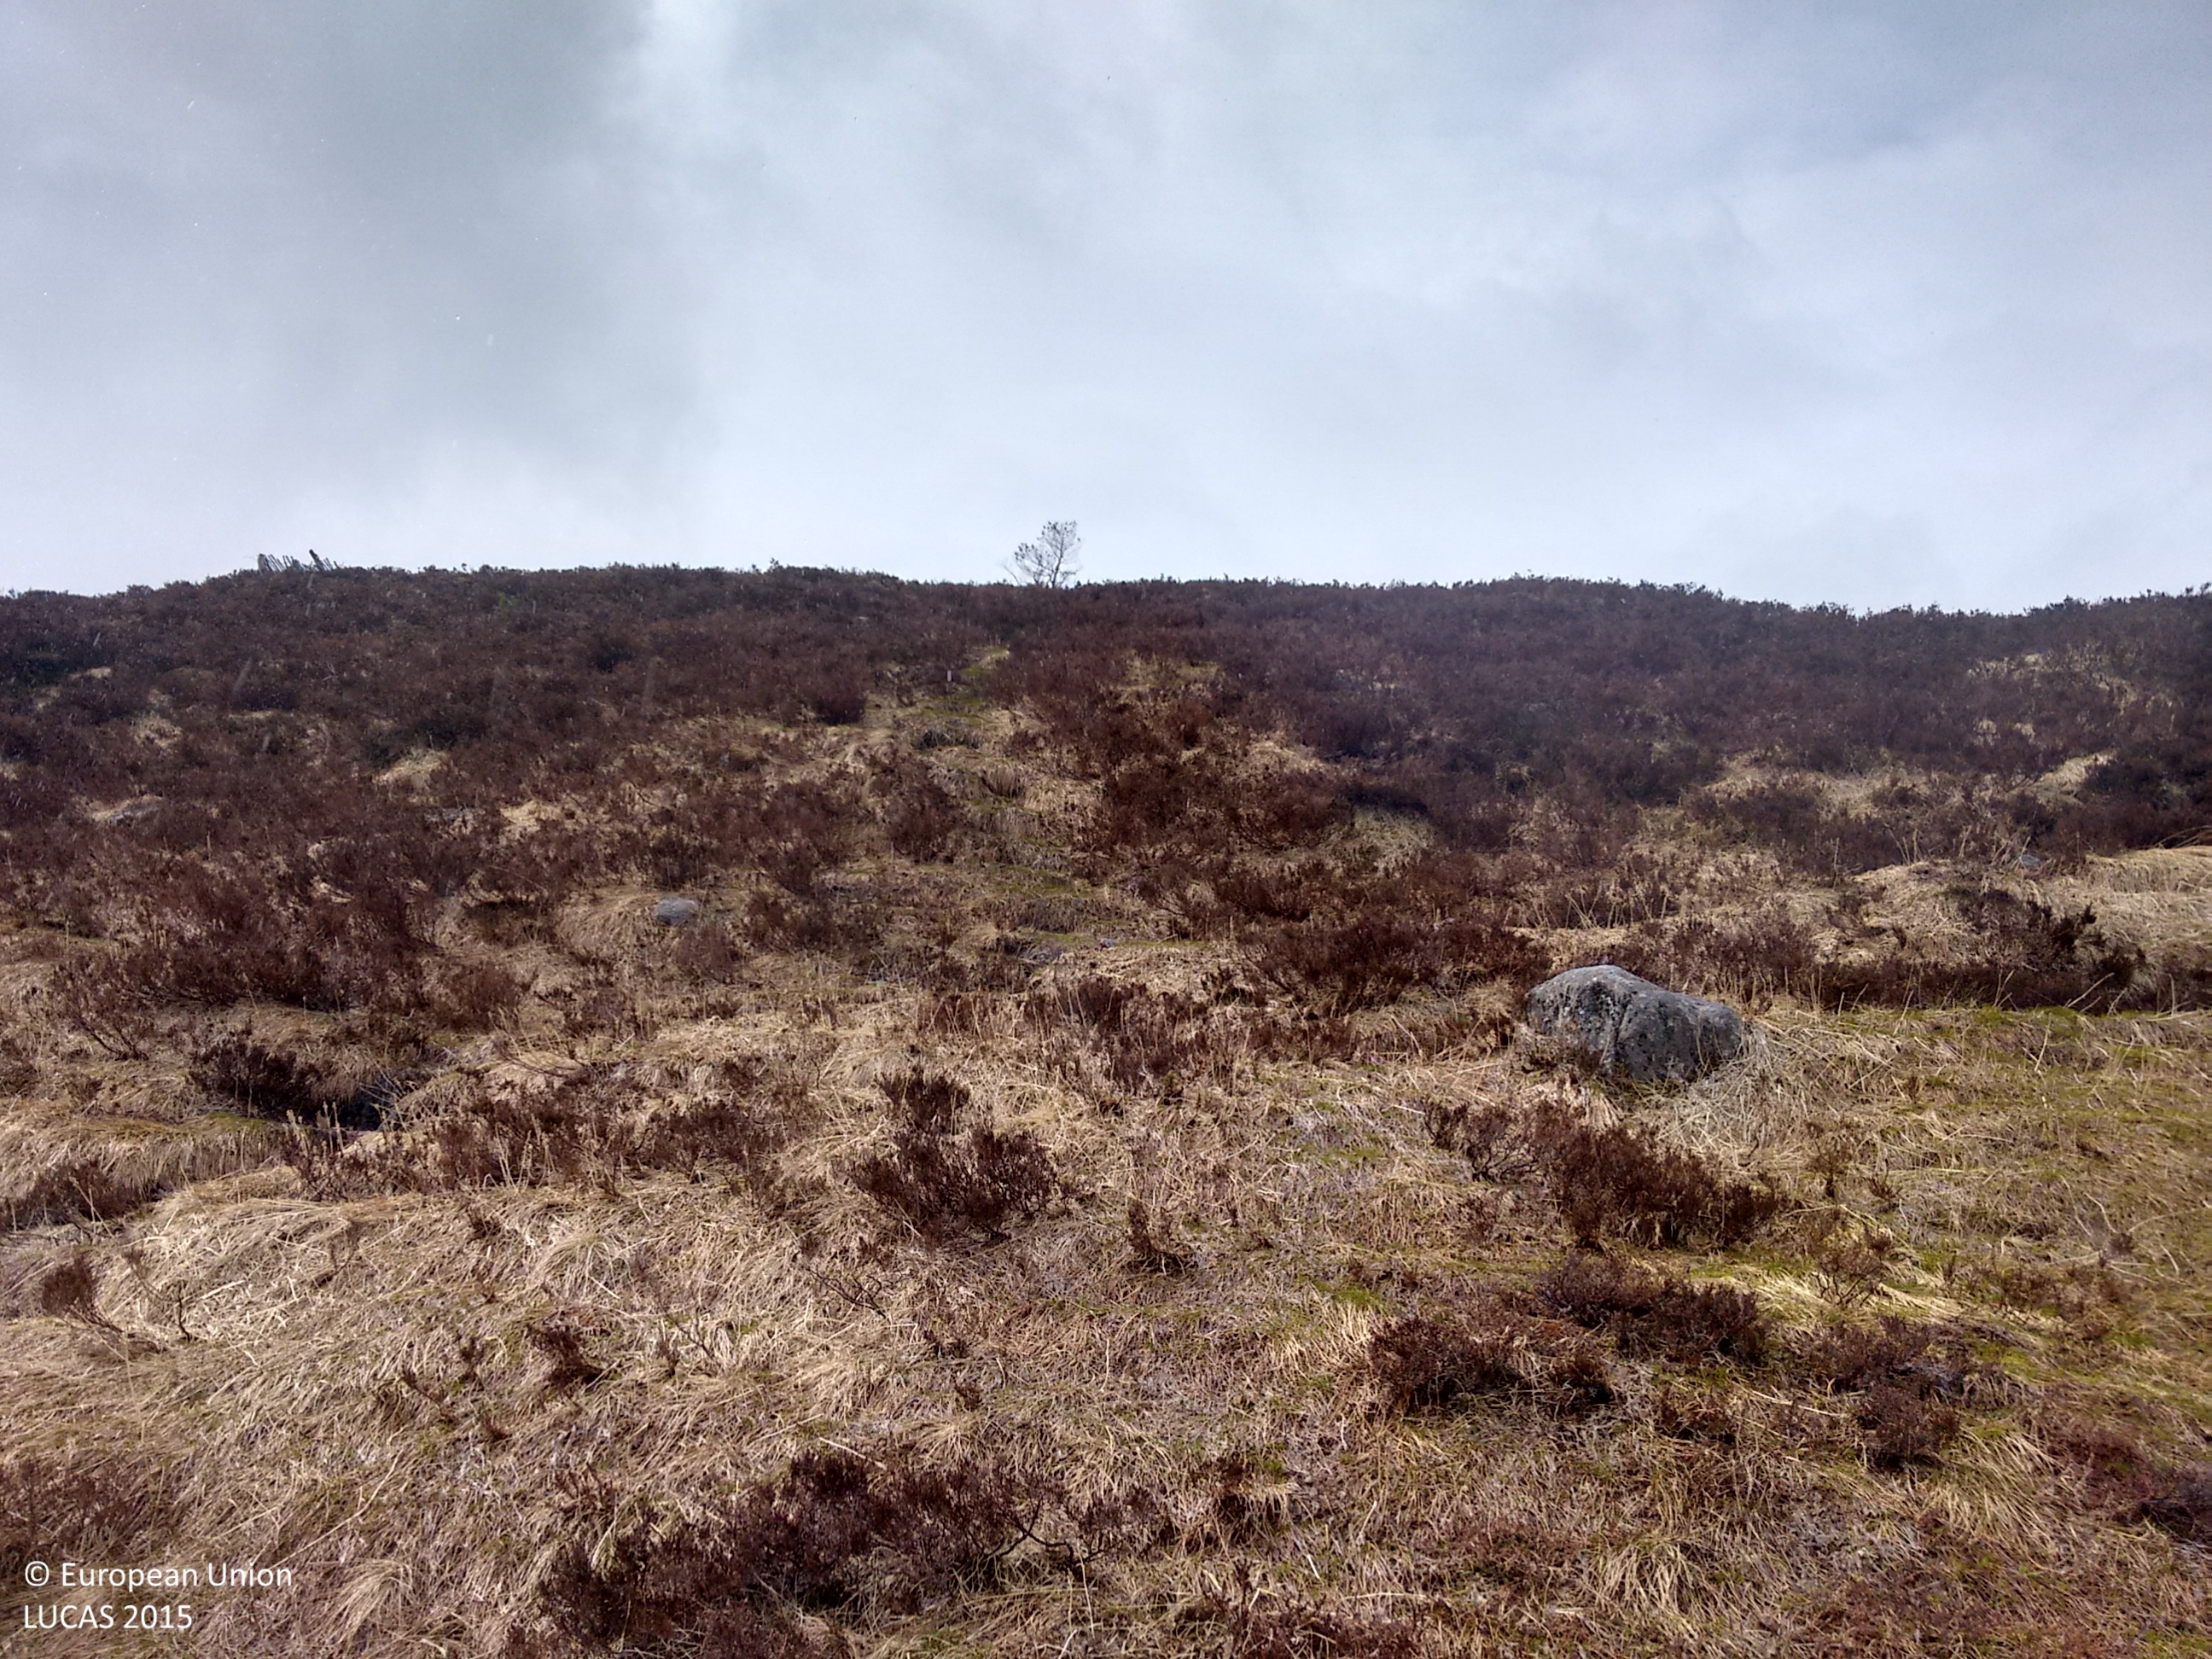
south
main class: Shrubland
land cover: Shrubland without tree cover
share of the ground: > 75 %
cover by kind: shrubs 55 %, herbaceous plants 40 %, unconsolidated bare surface 5 %
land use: Sport
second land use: Amenities, museums, leisure
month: June
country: GB
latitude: 57.1323
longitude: -3.6726
